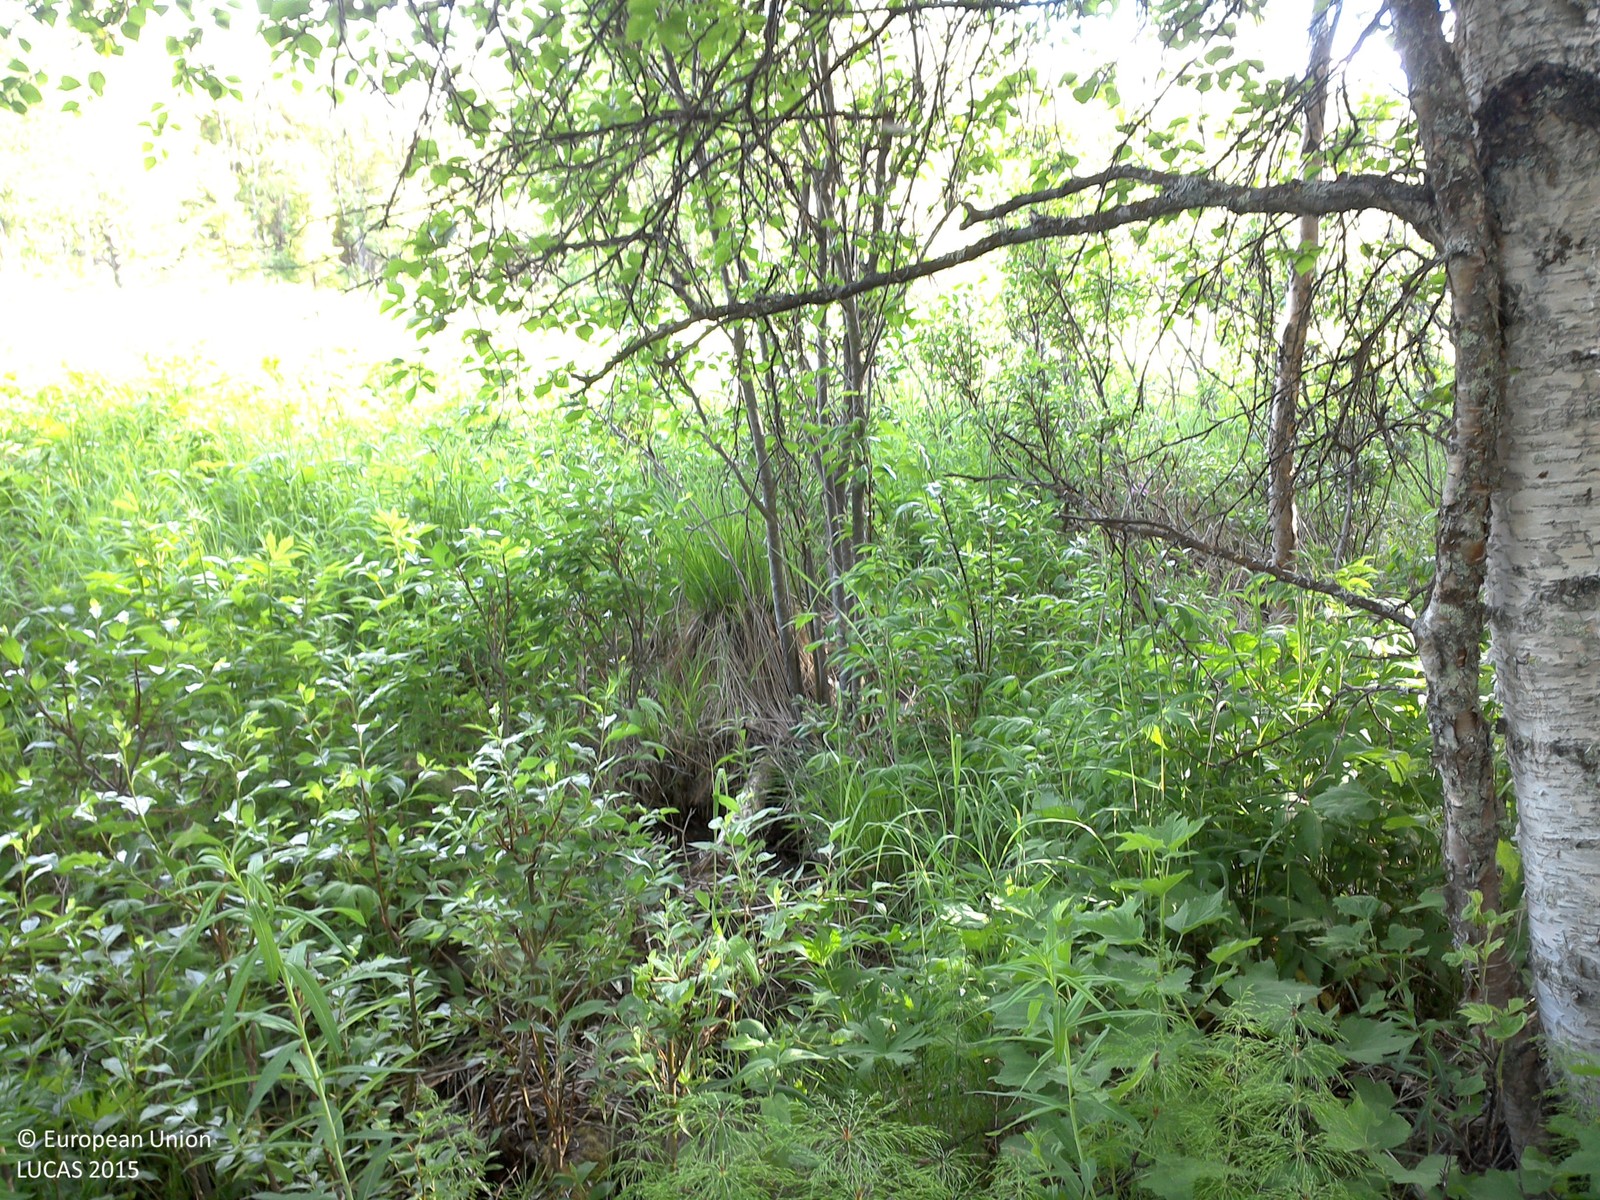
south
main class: Woodland
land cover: Broadleaved woodland
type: boreal forest
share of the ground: 25 - 50 %
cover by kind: herbaceous plants 45 %, broadleaved forest trees 40 %, shrubs 10 %, coniferous forest trees 5 %
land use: Residential
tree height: > 5 m
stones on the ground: 10 - 25 %
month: June
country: SE
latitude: 66.7902
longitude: 22.9108
